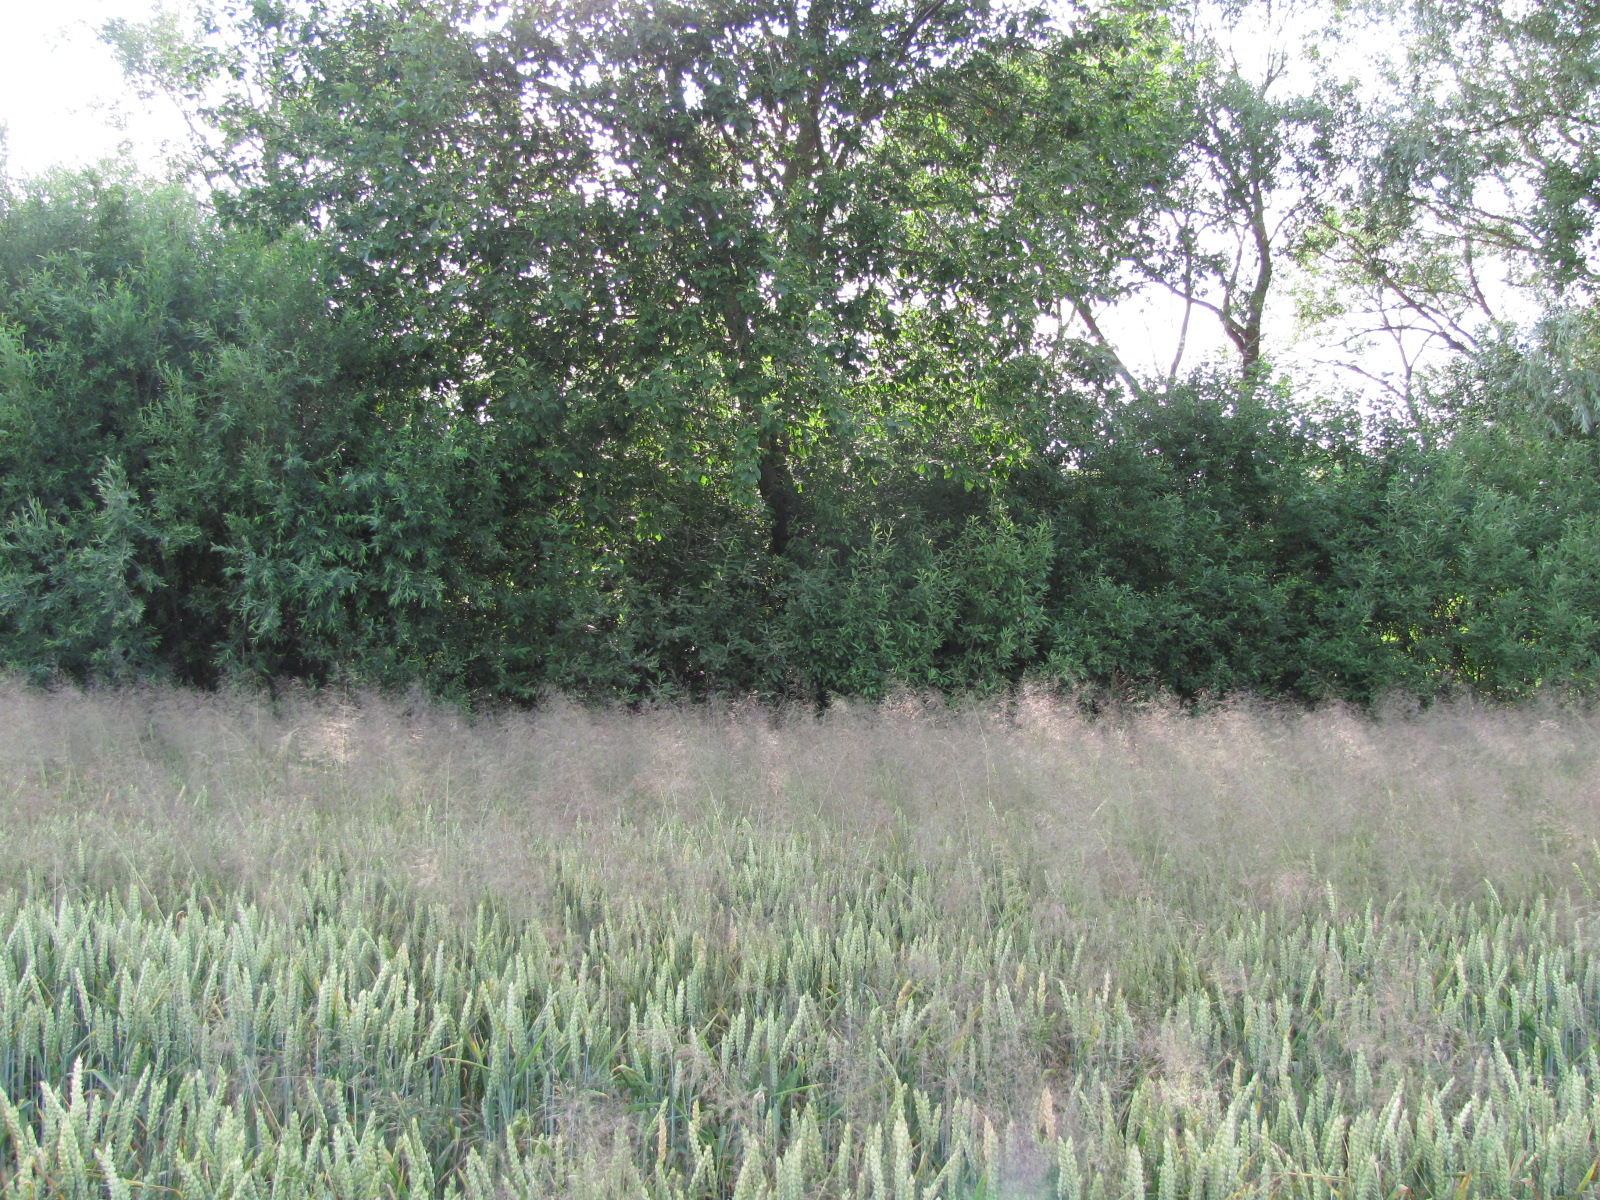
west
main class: Cropland
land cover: Common wheat
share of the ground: > 75 %
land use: Agriculture (excluding fallow land and kitchen gardens)
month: July
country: LV
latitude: 56.3561
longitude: 24.2522
